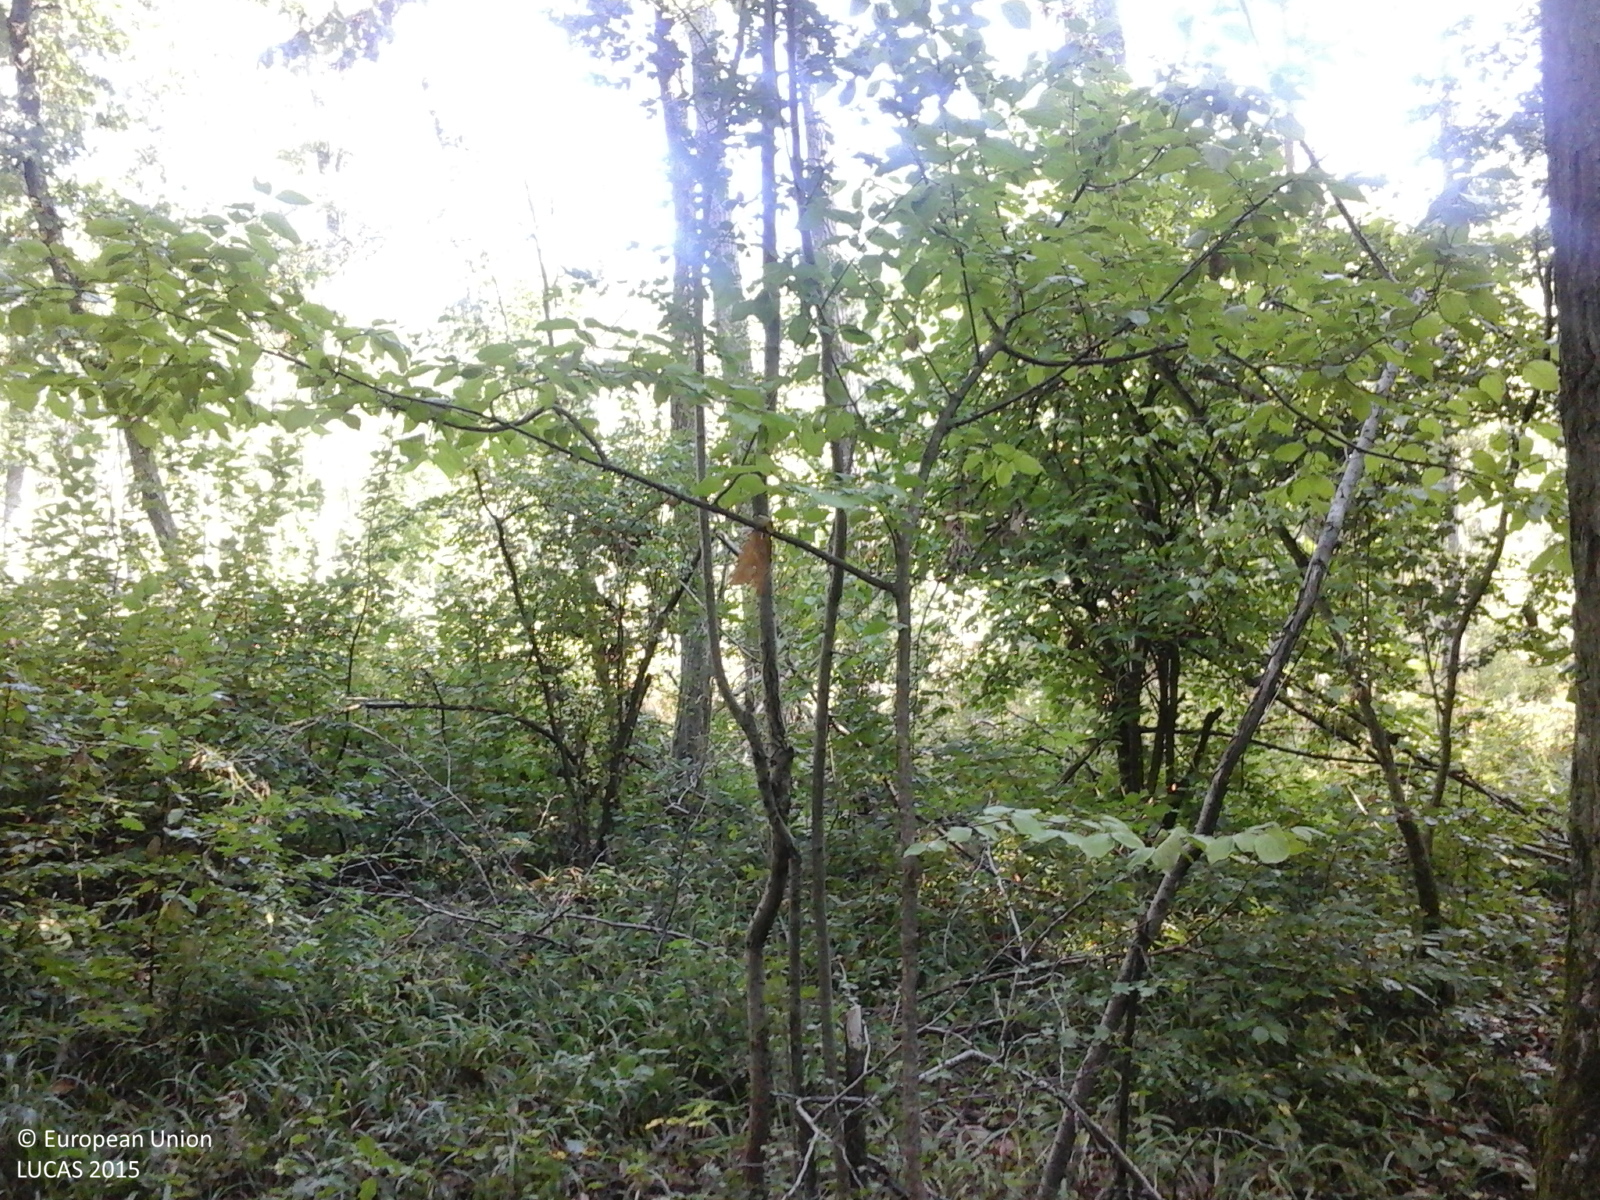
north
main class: Woodland
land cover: Broadleaved woodland
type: beech forest
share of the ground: > 75 %
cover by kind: broadleaved forest trees 100 %
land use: Forestry
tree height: > 5 m
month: September
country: RO
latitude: 47.4452
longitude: 22.8867
